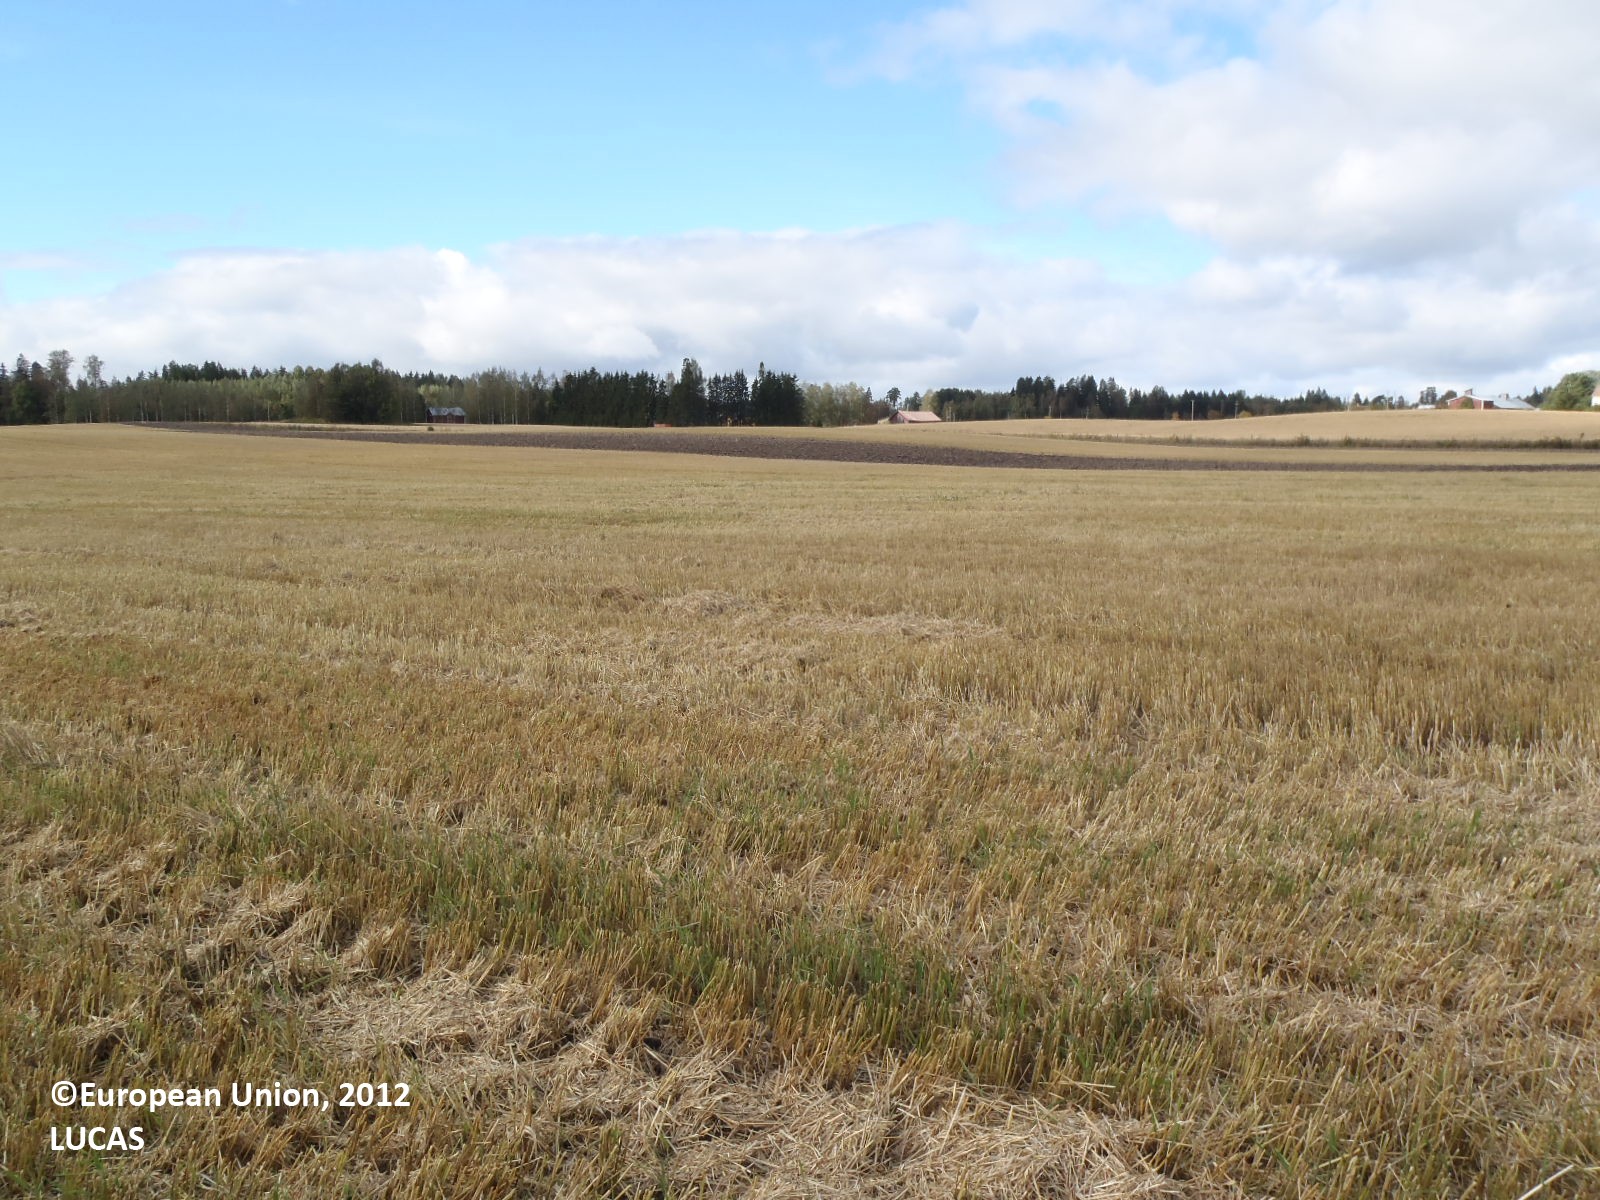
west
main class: Cropland
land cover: Barley
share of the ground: > 75 %
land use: Agriculture (excluding fallow land and kitchen gardens)
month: September
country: FI
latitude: 61.3350
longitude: 22.7575
